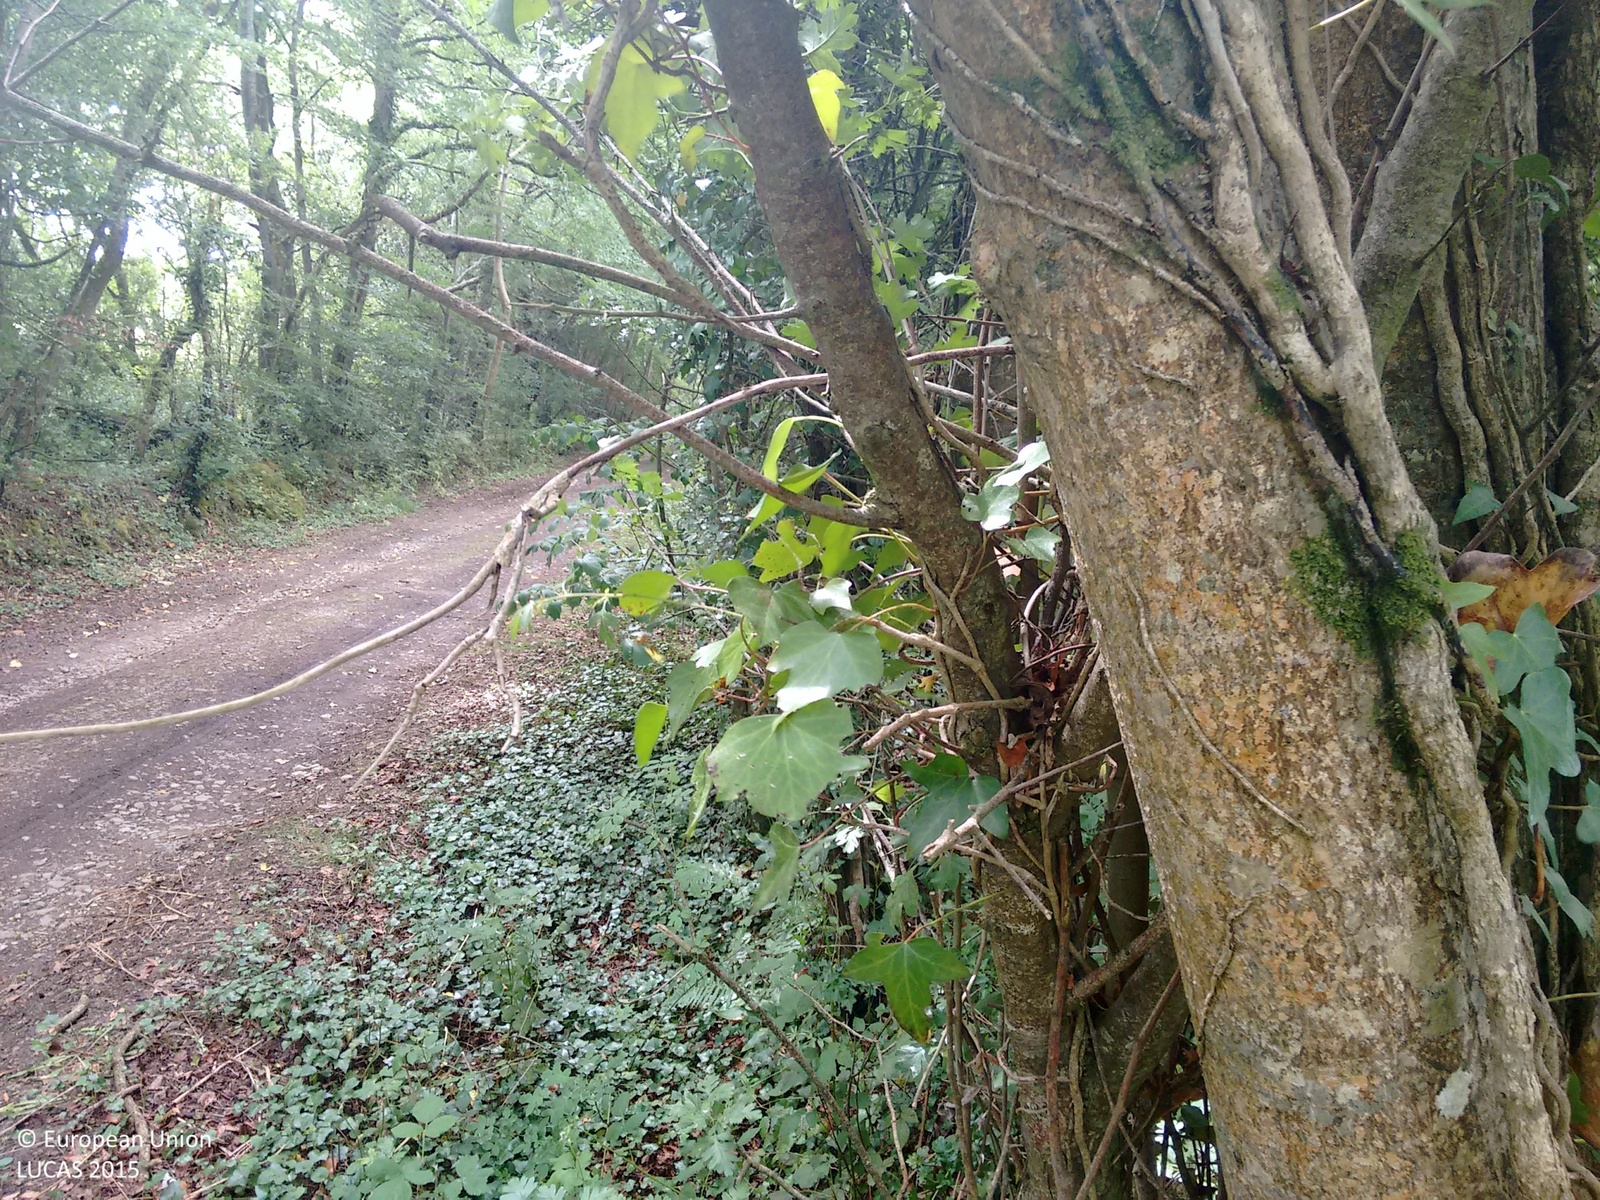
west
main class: Cropland
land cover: Oats
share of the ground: > 75 %
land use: Agriculture (excluding fallow land and kitchen gardens)
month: July
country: IE
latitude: 52.1685
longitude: -8.9097
